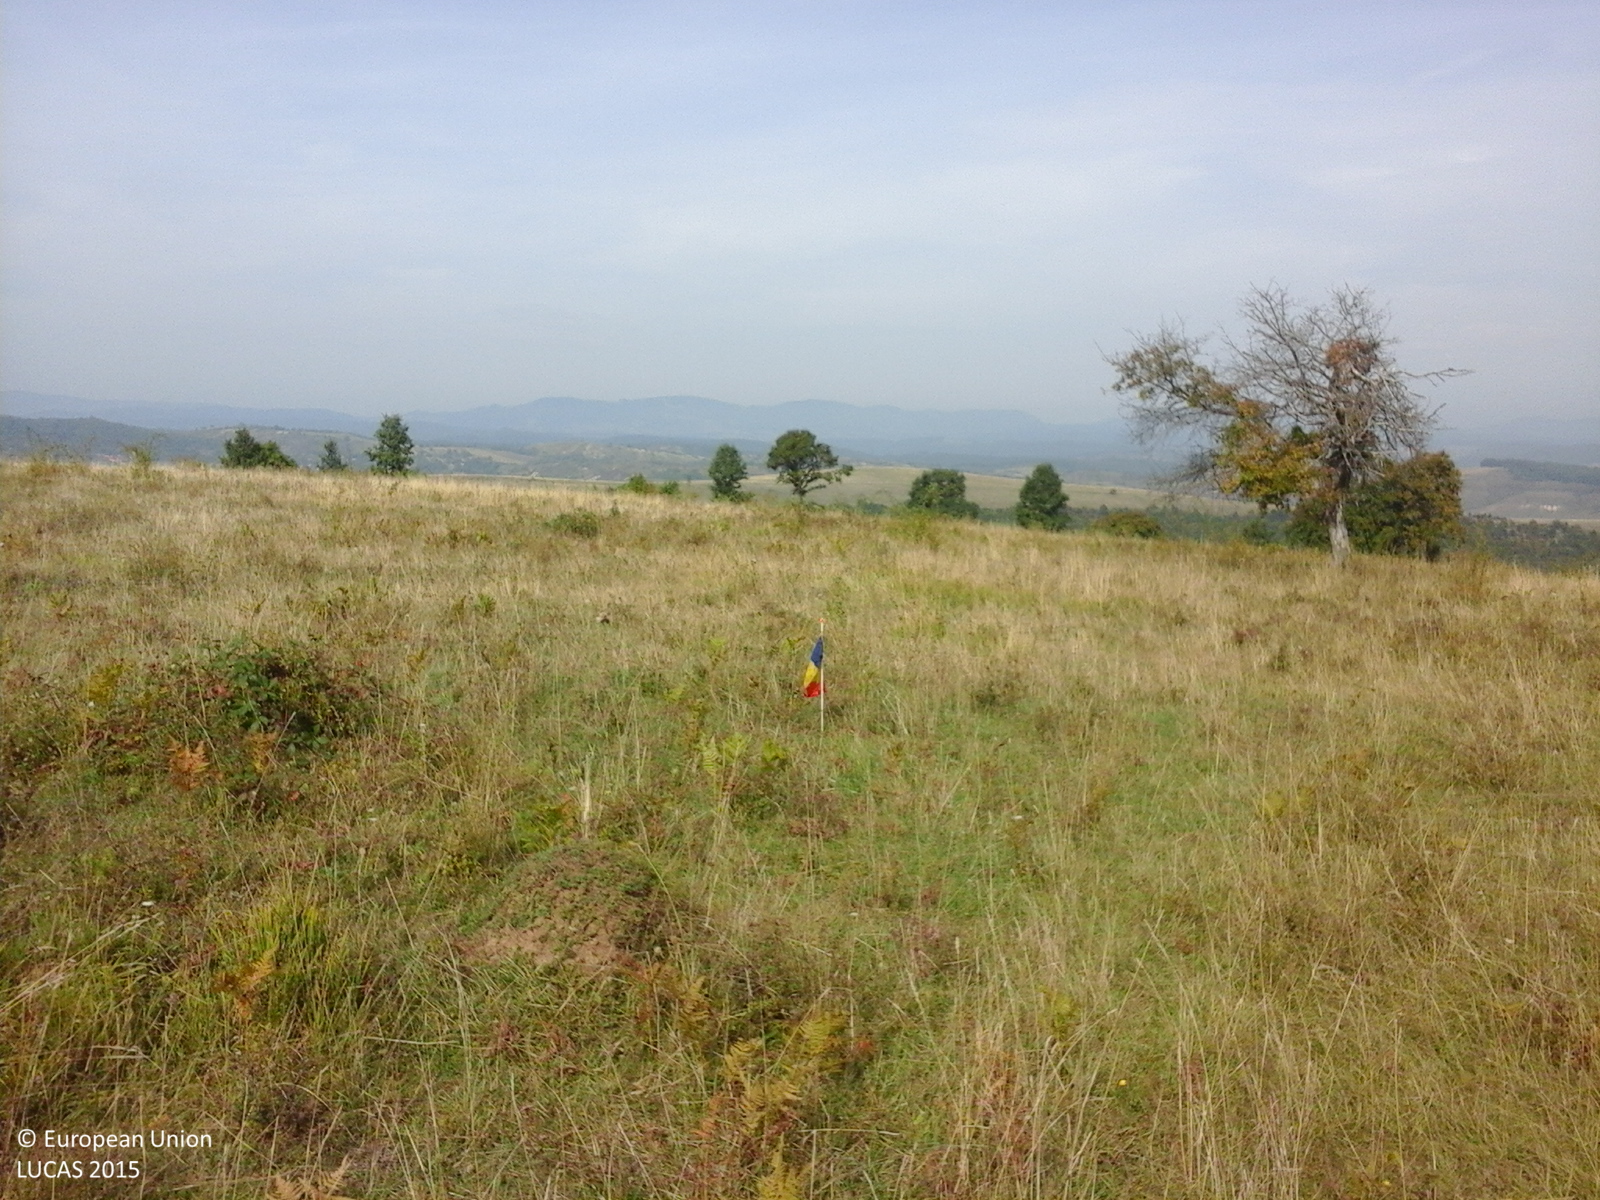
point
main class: Grassland
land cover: Grassland with sparse tree/shrub cover
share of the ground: > 75 %
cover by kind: herbaceous plants 85 %, shrubs 10 %, broadleaved forest trees 5 %
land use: Fallow land
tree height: < 5 m
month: September
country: RO
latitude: 46.8736
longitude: 23.0914
